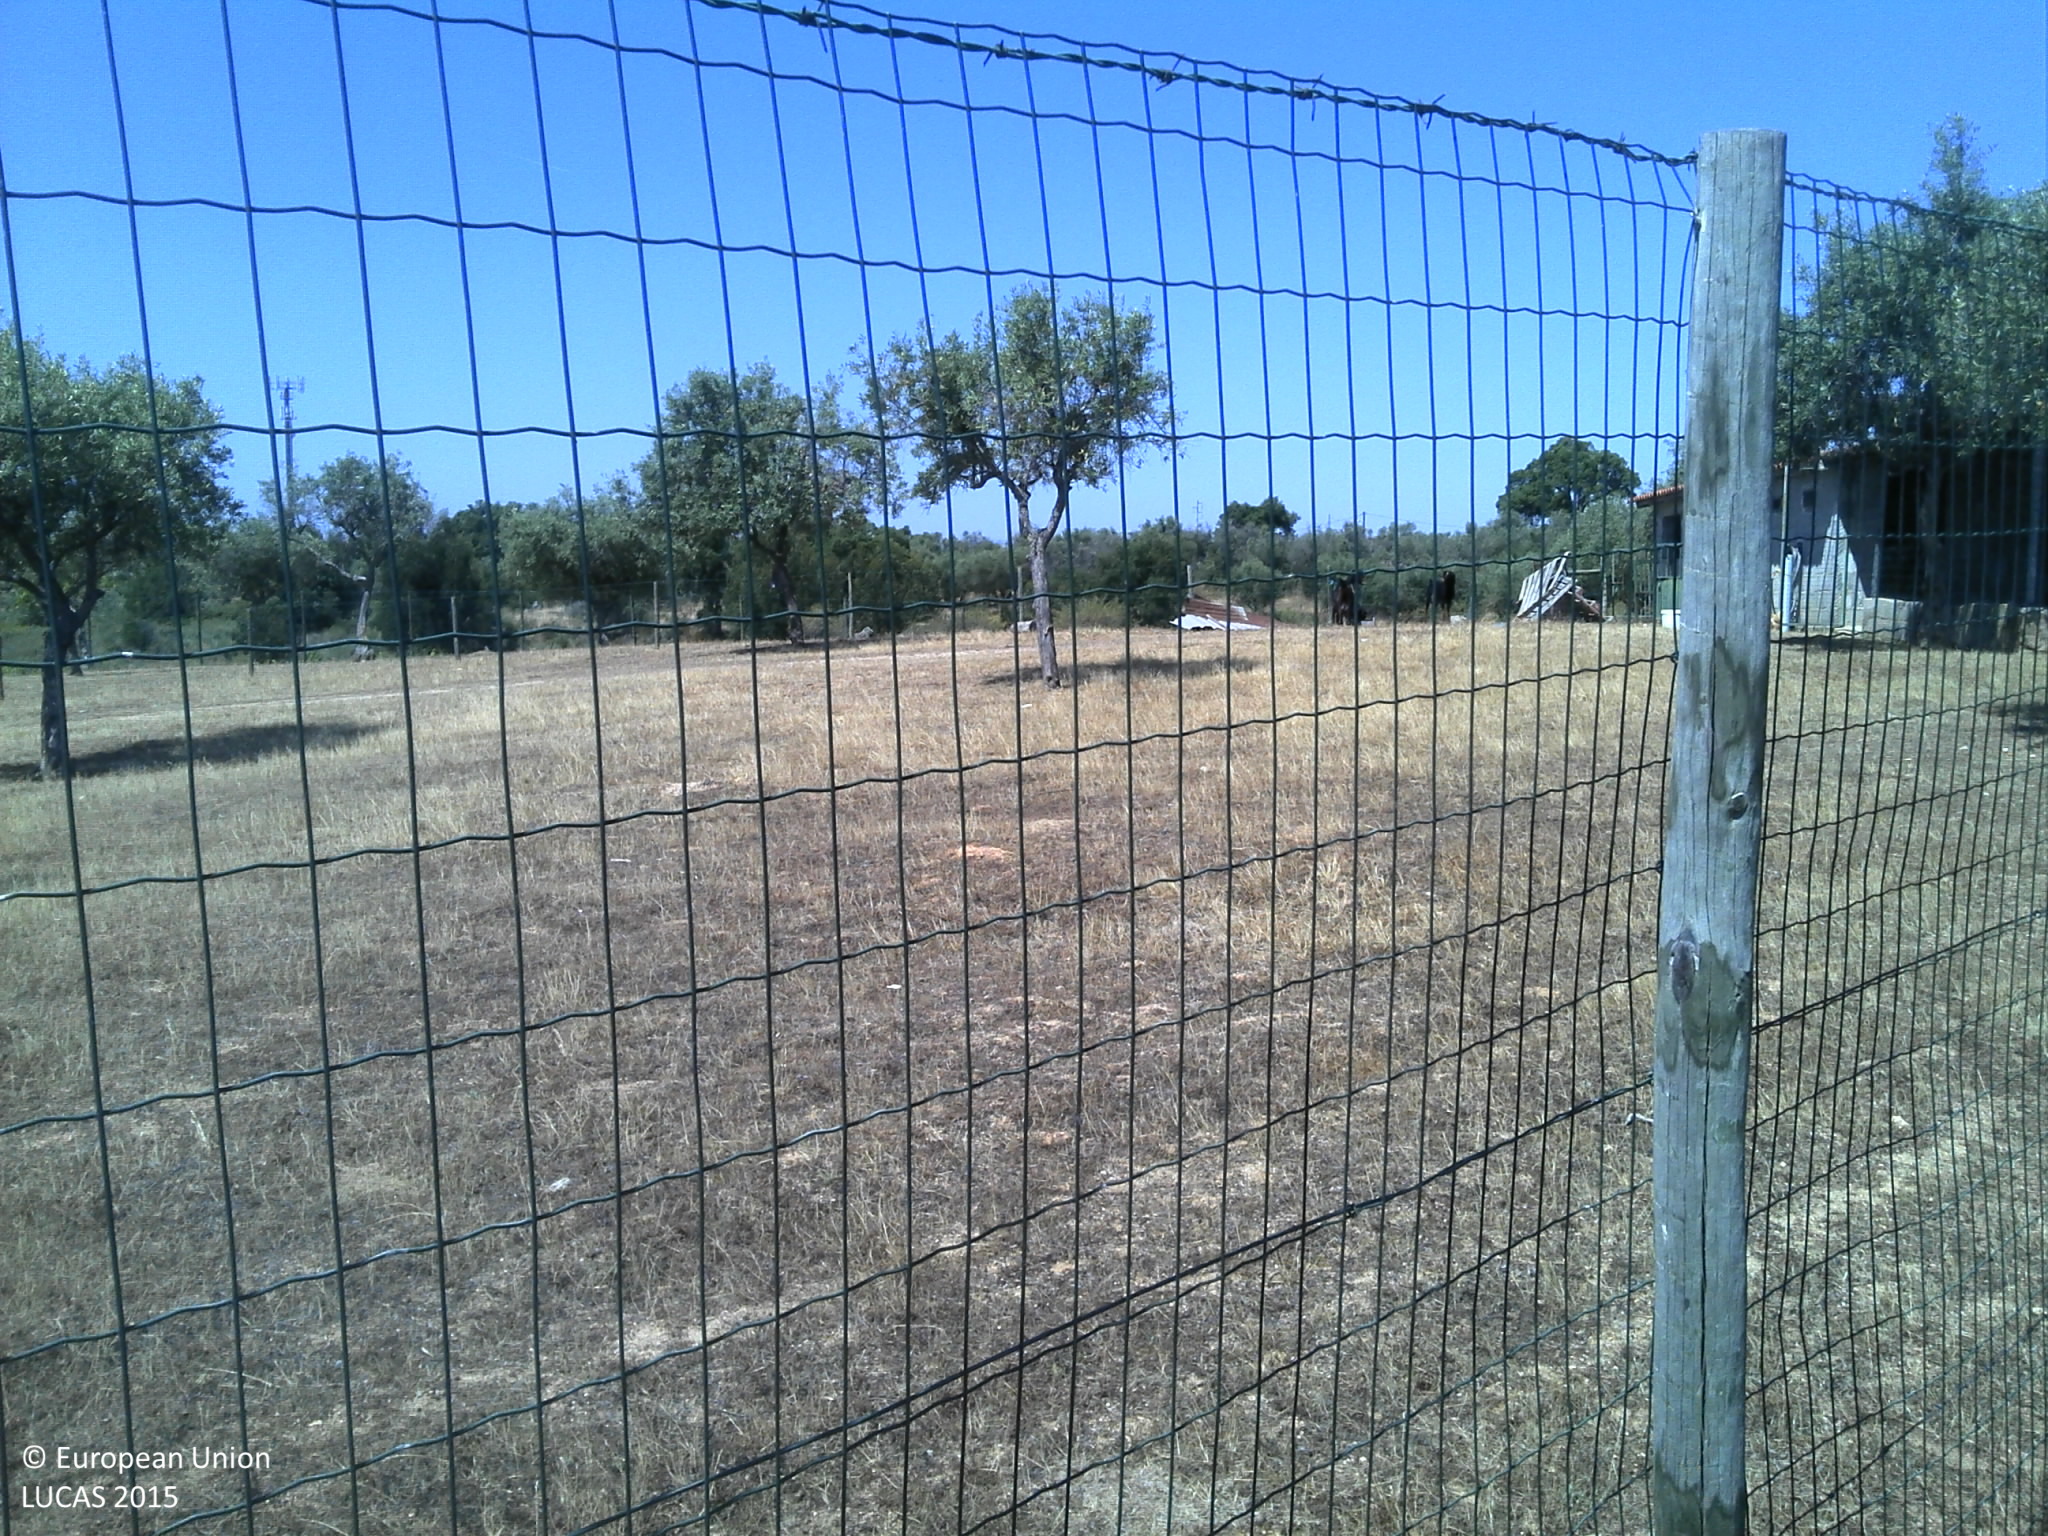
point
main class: Cropland
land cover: Olive groves
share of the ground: 25 - 50 %
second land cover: Grassland without tree/shrub cover
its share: 50 - 75 %
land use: Agriculture (excluding fallow land and kitchen gardens)
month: June
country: PT
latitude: 40.0252
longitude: -7.3113
